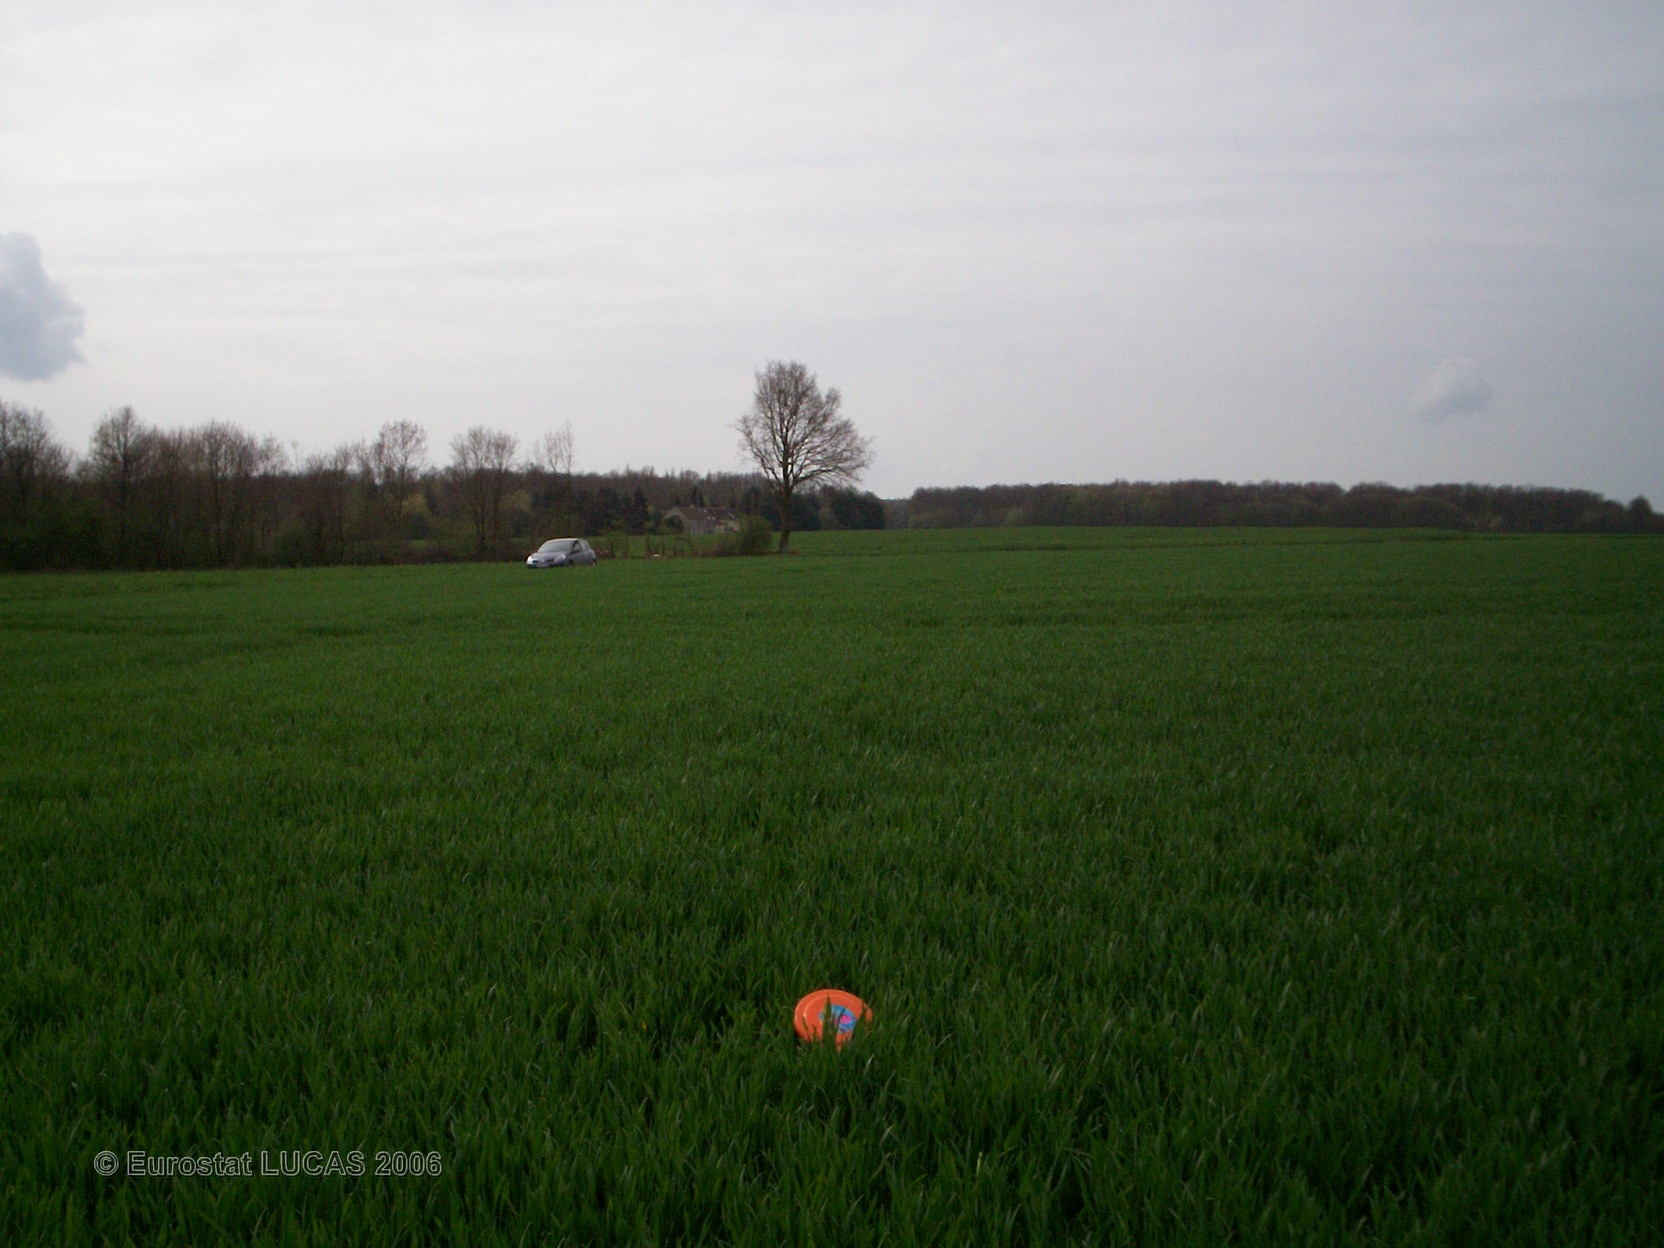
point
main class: Cropland
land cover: Common wheat
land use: Agriculture (excluding fallow land and kitchen gardens)
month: April
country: FR
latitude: 48.2829
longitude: 2.8898
